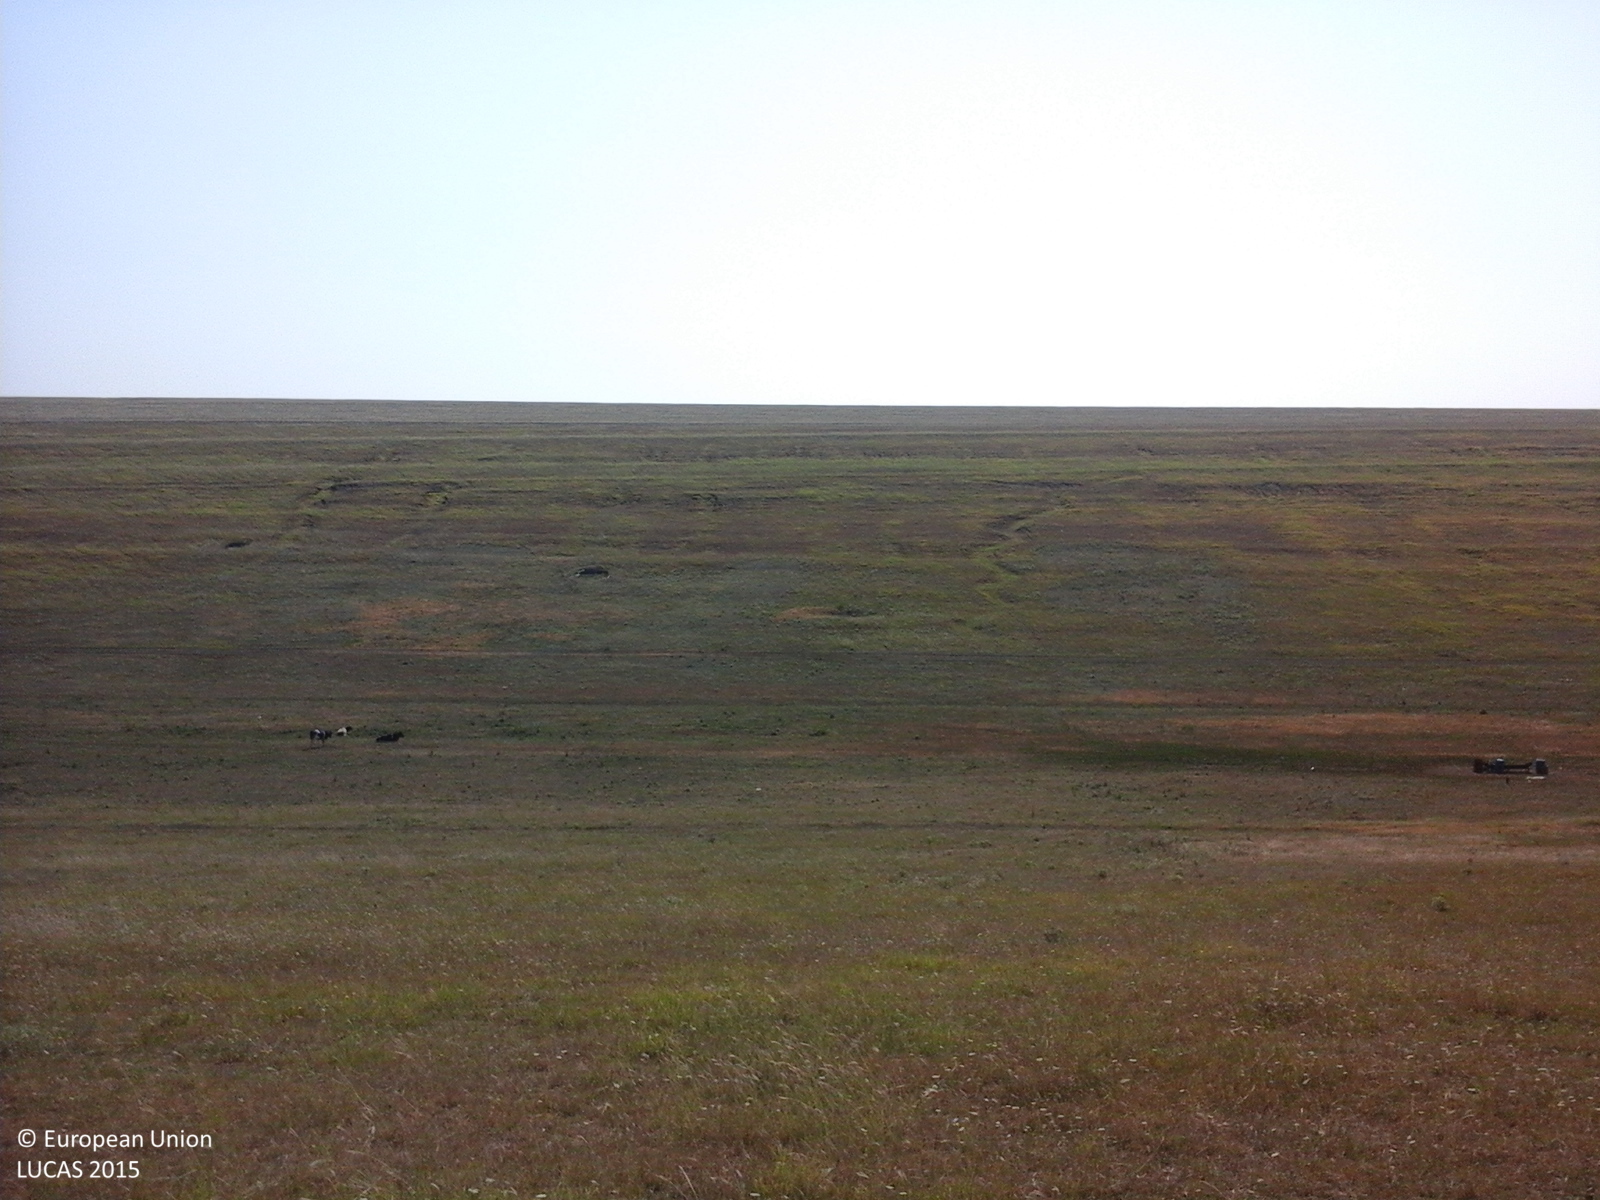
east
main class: Grassland
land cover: Grassland without tree/shrub cover
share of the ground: > 75 %
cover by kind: herbaceous plants 100 %
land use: Agriculture (excluding fallow land and kitchen gardens)
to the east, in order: Grassland without tree/shrub cover; Tracks; Grassland without tree/shrub cover; Tracks; Grassland without tree/shrub cover
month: July
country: RO
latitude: 45.6522
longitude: 27.9147
